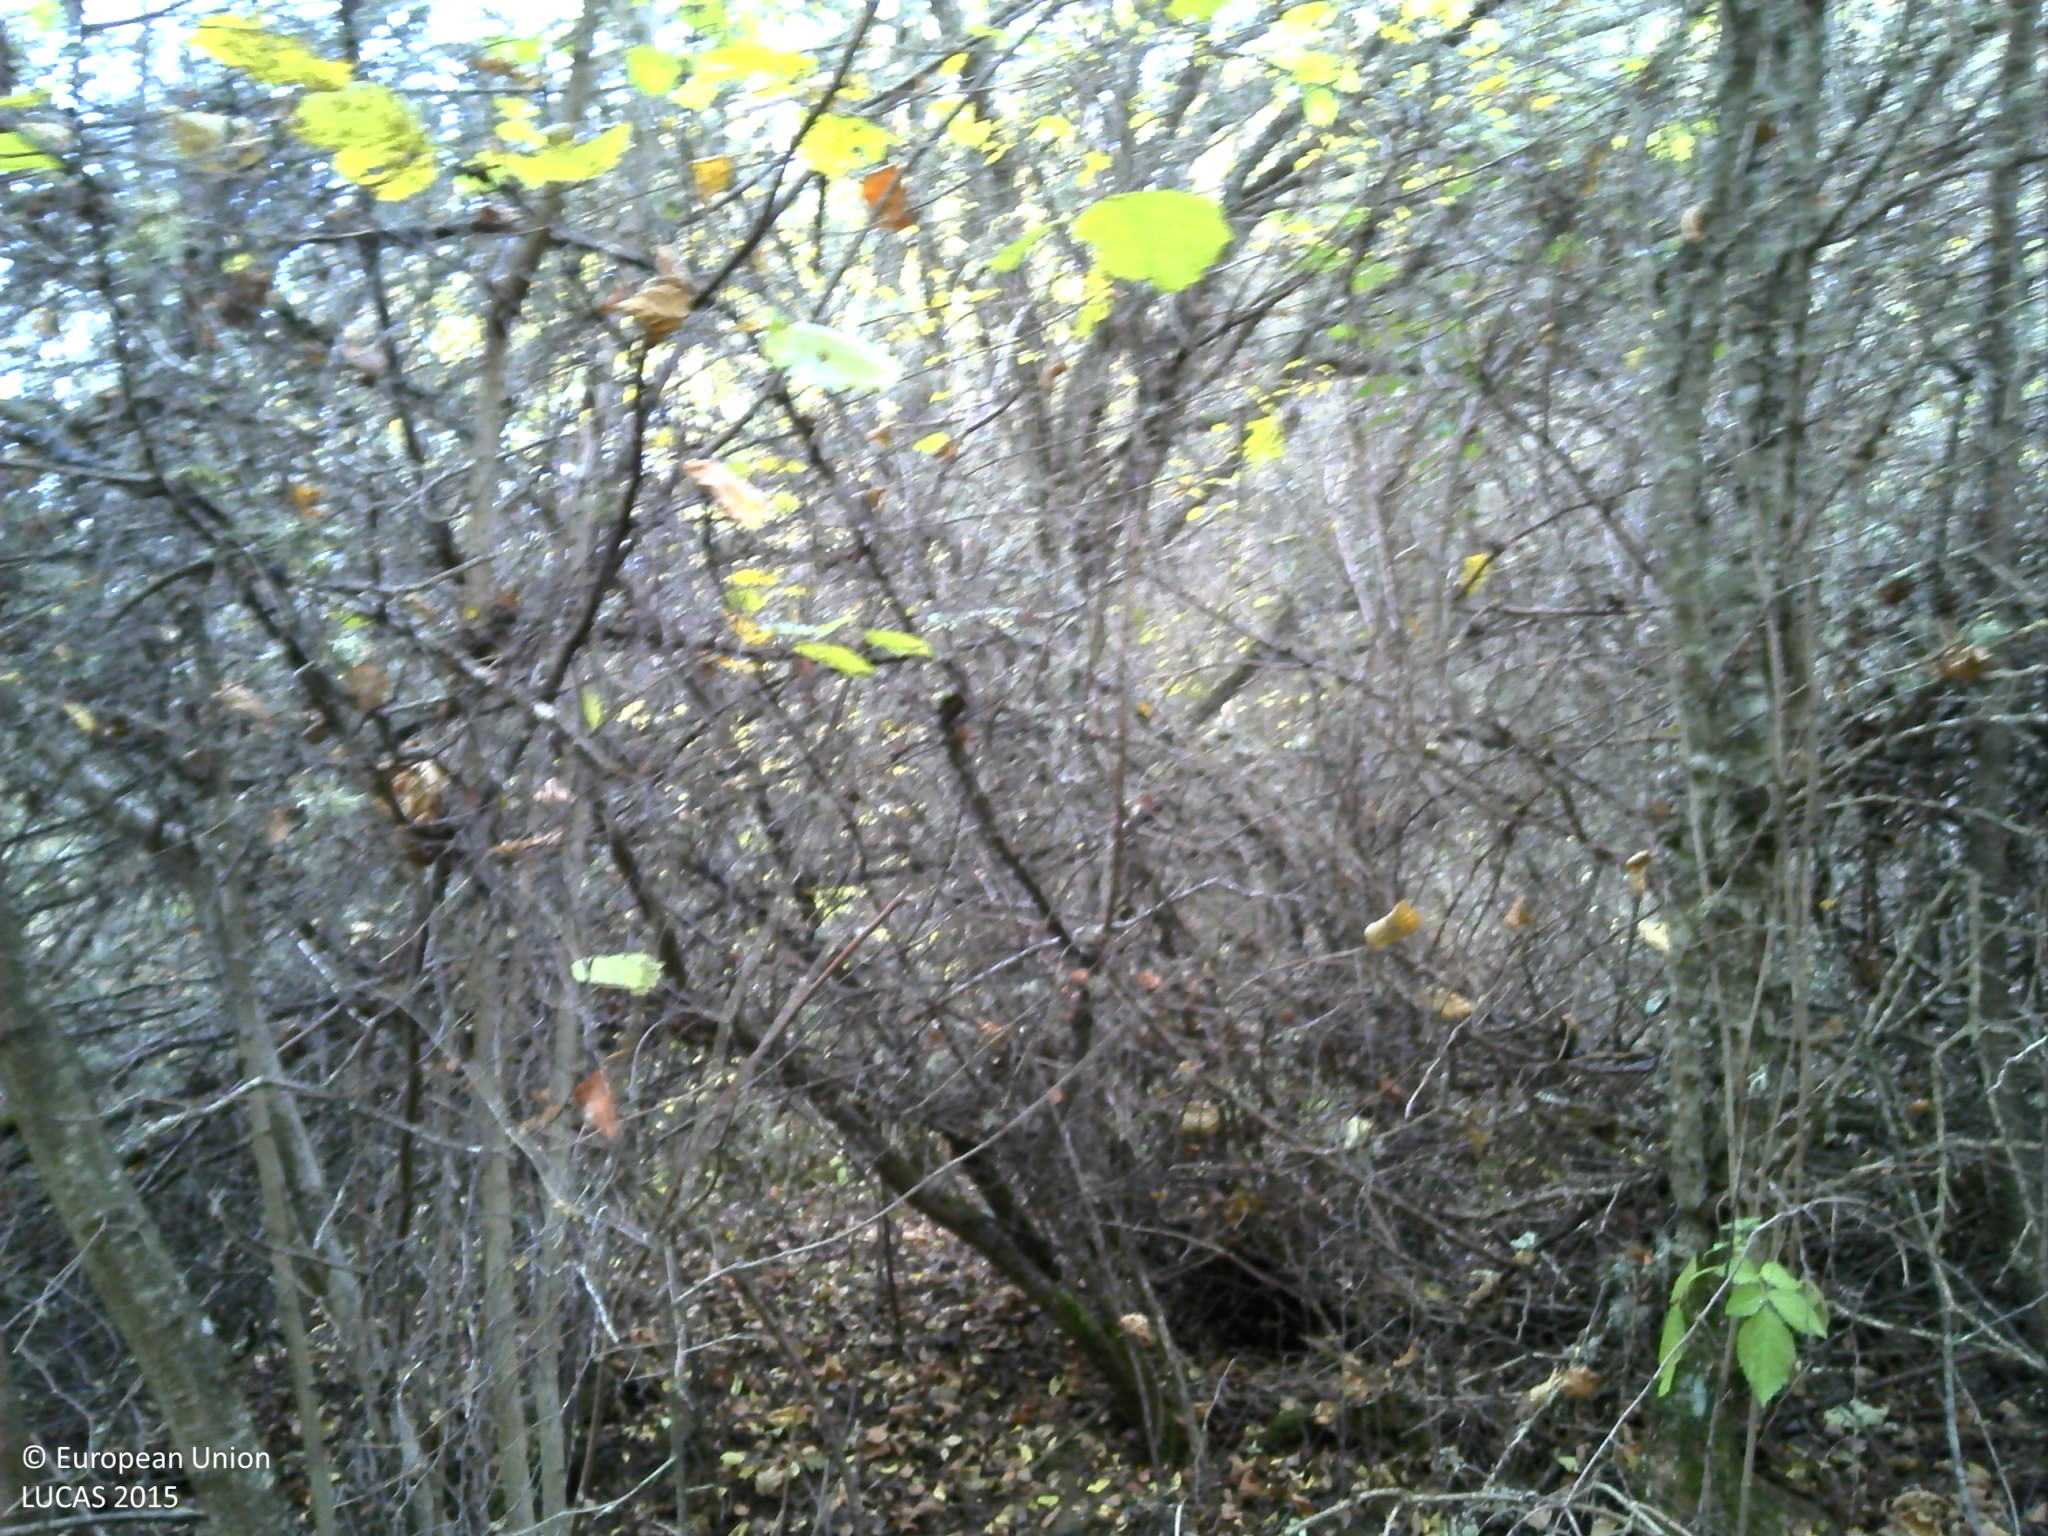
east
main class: Woodland
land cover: Broadleaved woodland
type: non-riverine alder, birch or aspen forest
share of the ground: > 75 %
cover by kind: broadleaved forest trees 70 %, shrubs 30 %
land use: Forestry
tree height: > 5 m
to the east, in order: Broadleaved woodland; Tracks; Fences; Broadleaved woodland; Grassland without tree/shrub cover; Broadleaved woodland; Grassland without tree/shrub cover; Broadleaved woodland; Grassland without tree/shrub cover
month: October
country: FR
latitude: 45.7853
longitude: 2.8342
